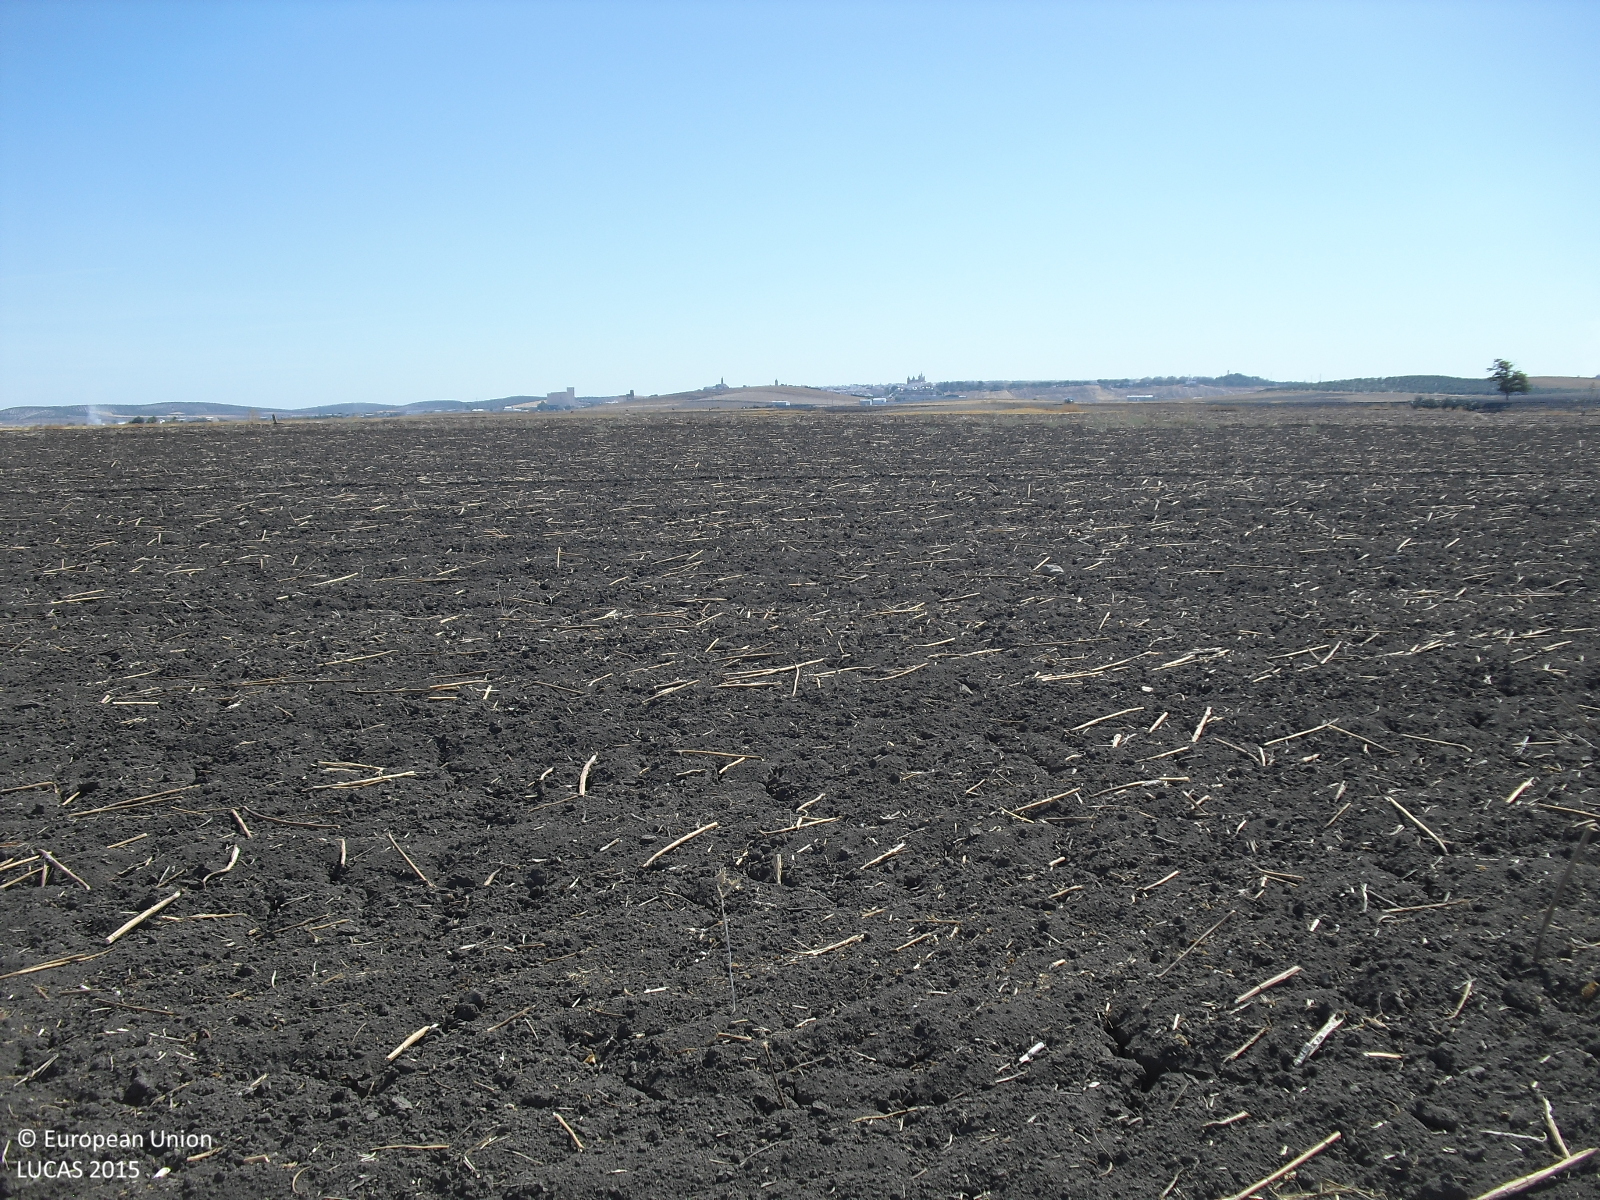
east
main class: Cropland
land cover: Sunflower
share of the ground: < 10 %
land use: Agriculture (excluding fallow land and kitchen gardens)
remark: Harvested field
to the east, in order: Sunflower
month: August
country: ES
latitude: 37.3218
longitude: -5.4630
